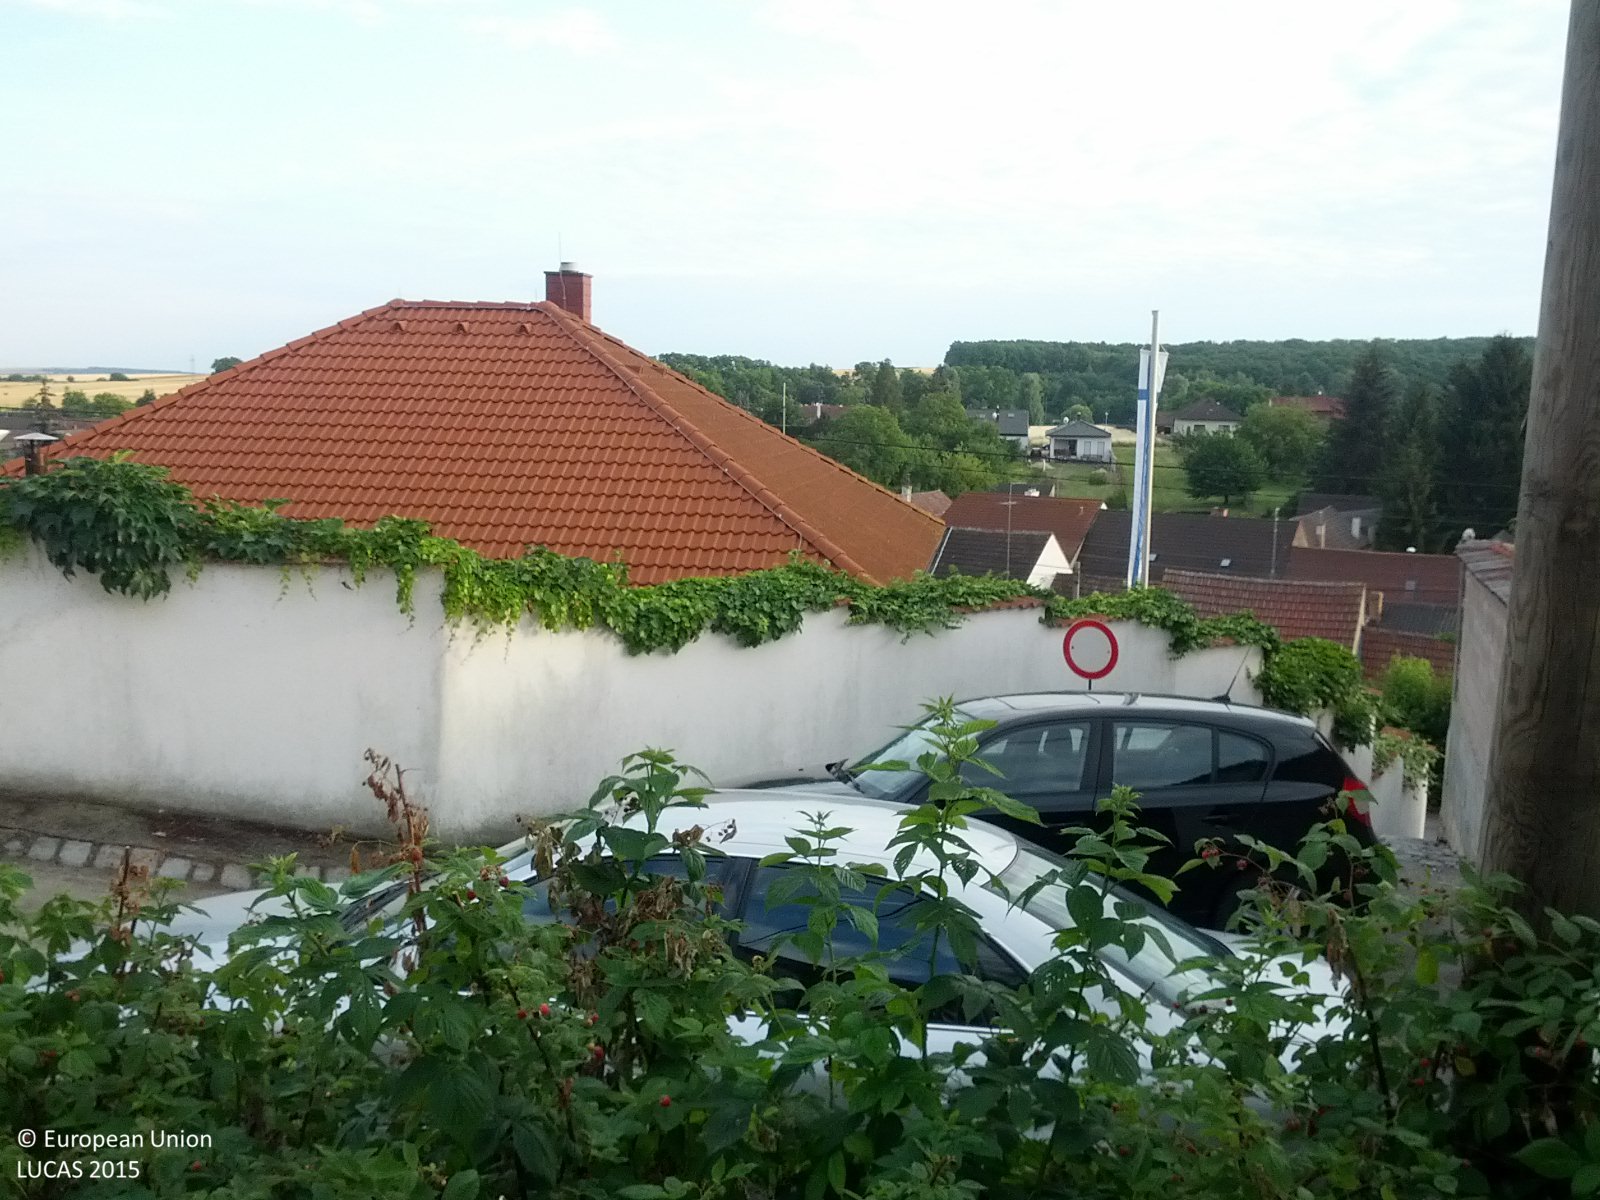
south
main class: Grassland
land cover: Grassland with sparse tree/shrub cover
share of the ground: > 75 %
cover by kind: herbaceous plants 80 %, shrubs 10 %, broadleaved forest trees 5 %, consolidated bare surface 5 %
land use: Residential
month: June
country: AT
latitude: 48.6255
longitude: 16.8319
